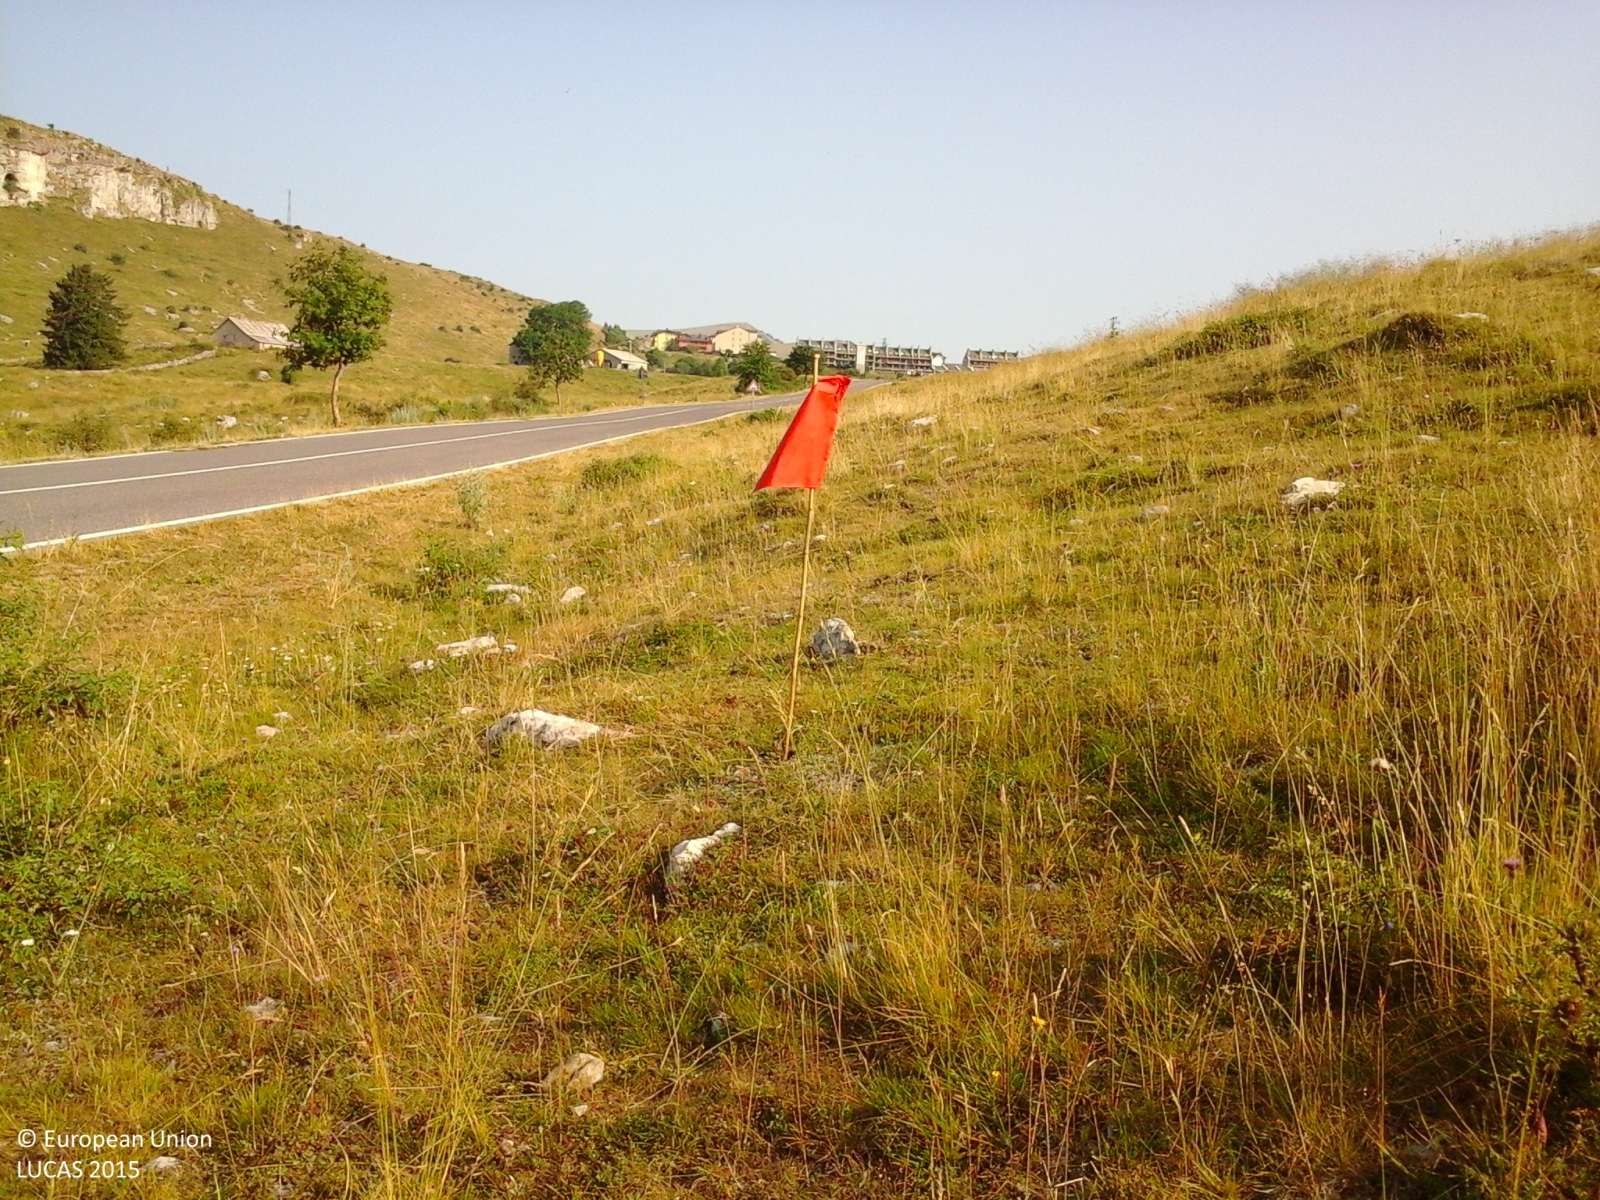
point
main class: Grassland
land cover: Grassland without tree/shrub cover
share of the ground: > 75 %
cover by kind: herbaceous plants 100 %
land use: Agriculture (excluding fallow land and kitchen gardens)
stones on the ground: 25 - 50 %
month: July
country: IT
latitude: 45.6790
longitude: 11.0895
